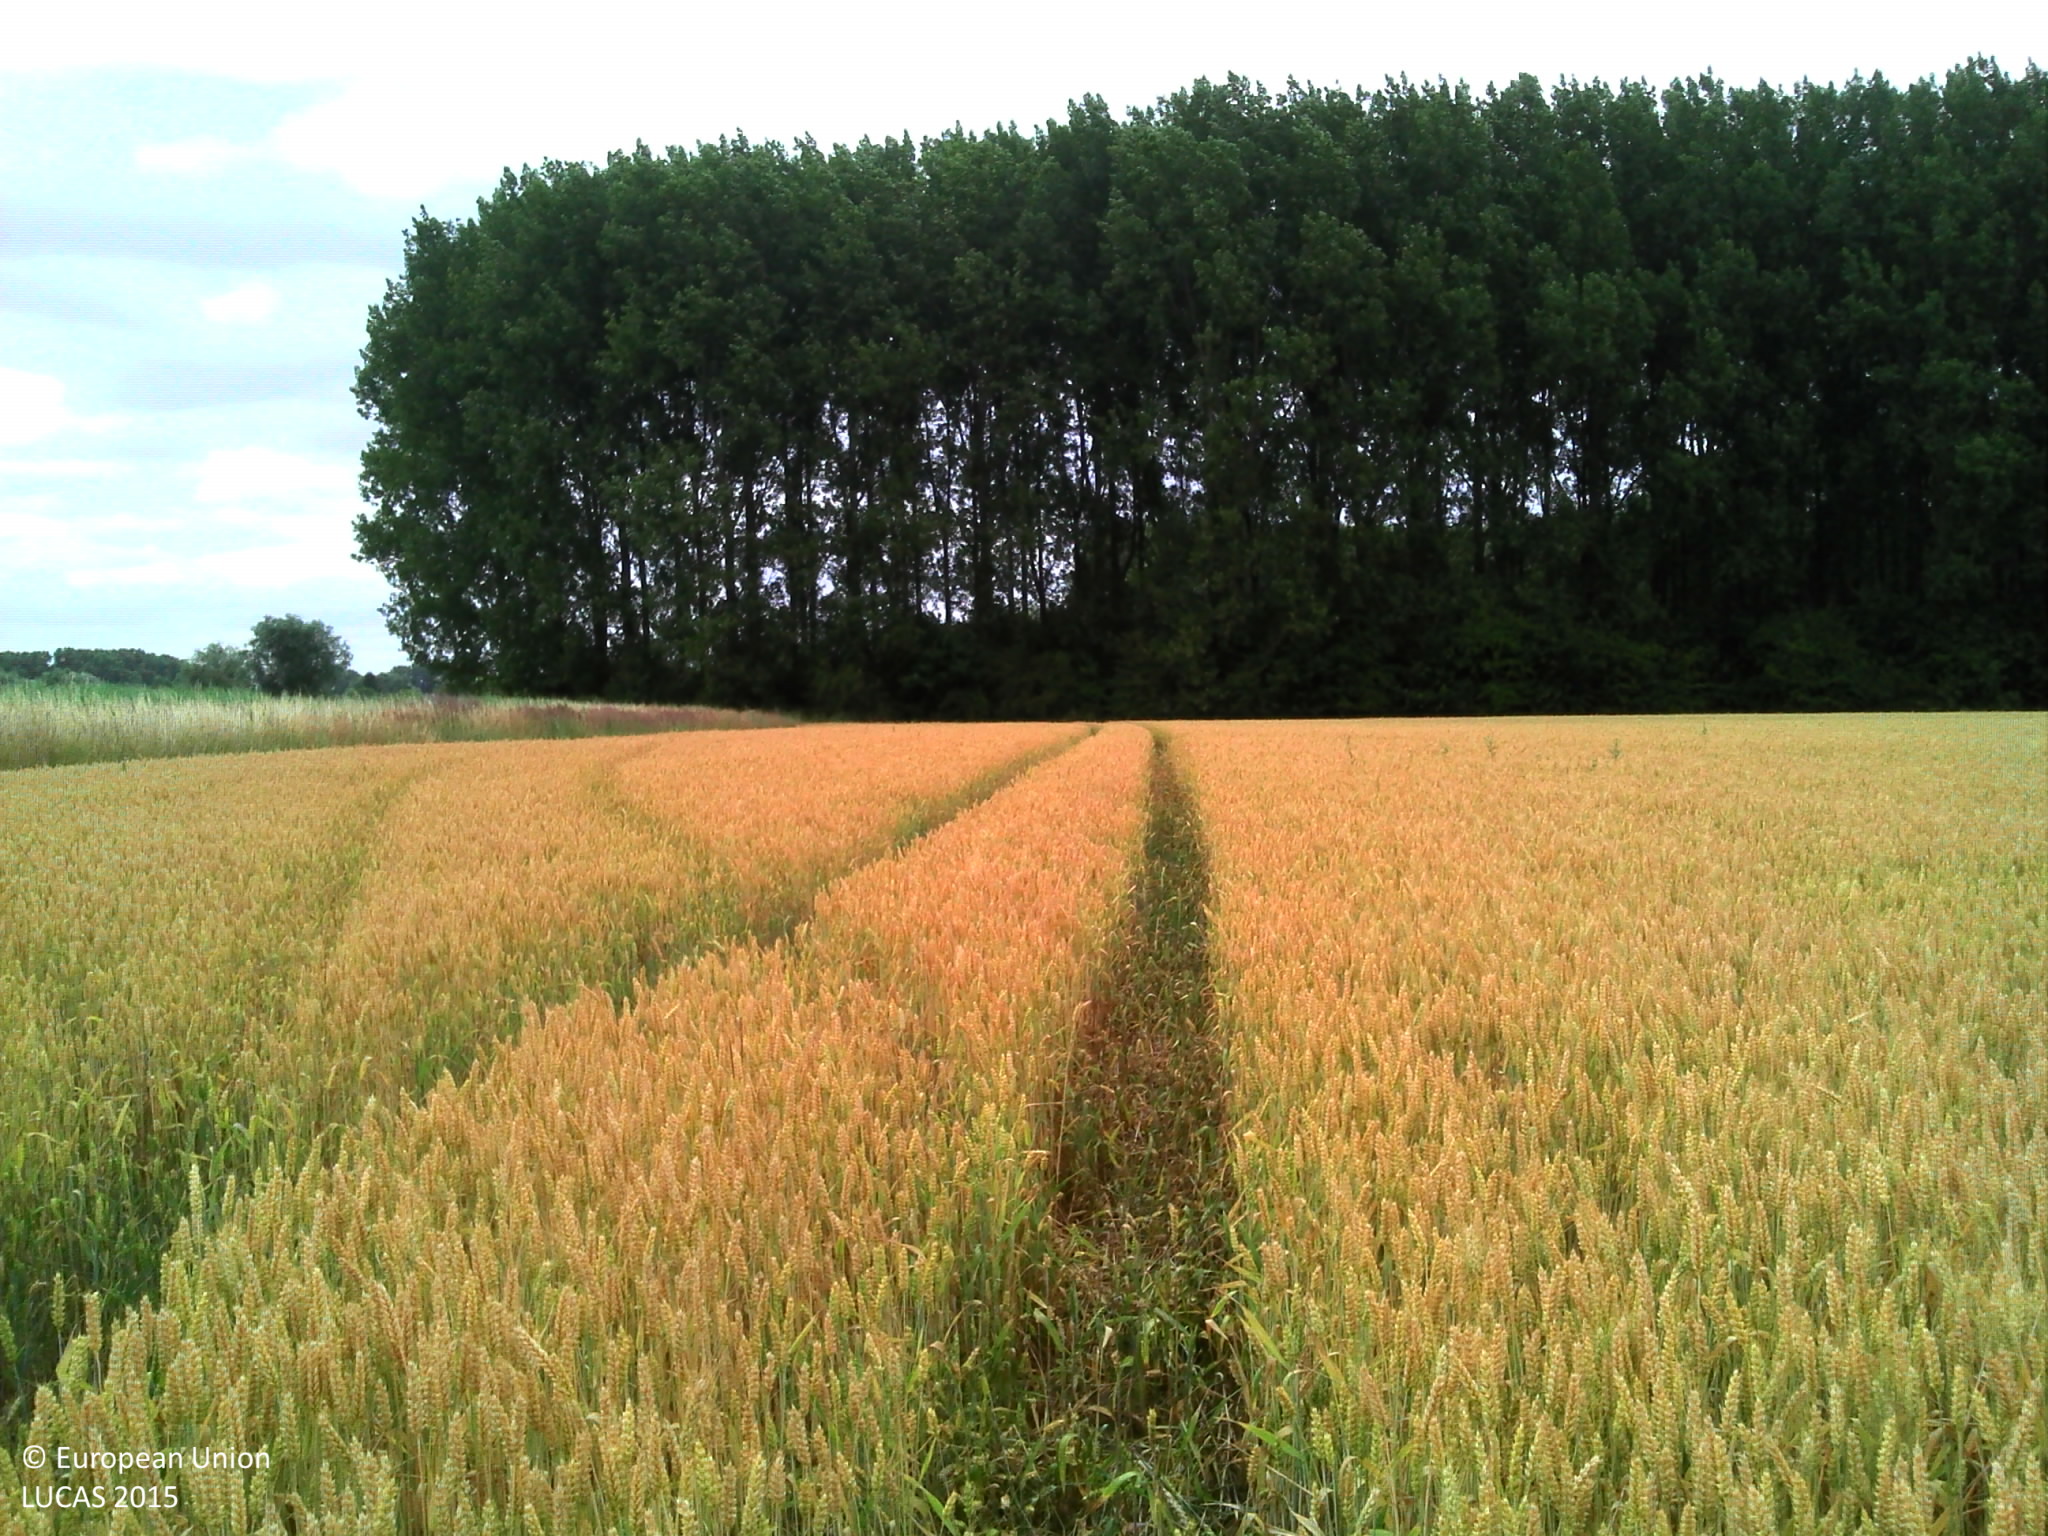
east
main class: Cropland
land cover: Common wheat
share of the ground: > 75 %
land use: Agriculture (excluding fallow land and kitchen gardens)
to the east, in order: Common wheat; Broadleaved woodland; Grassland without tree/shrub cover; Spontaneously vegetated surfaces; Grassland without tree/shrub cover
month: July
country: FR
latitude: 50.4251
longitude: 3.0791
